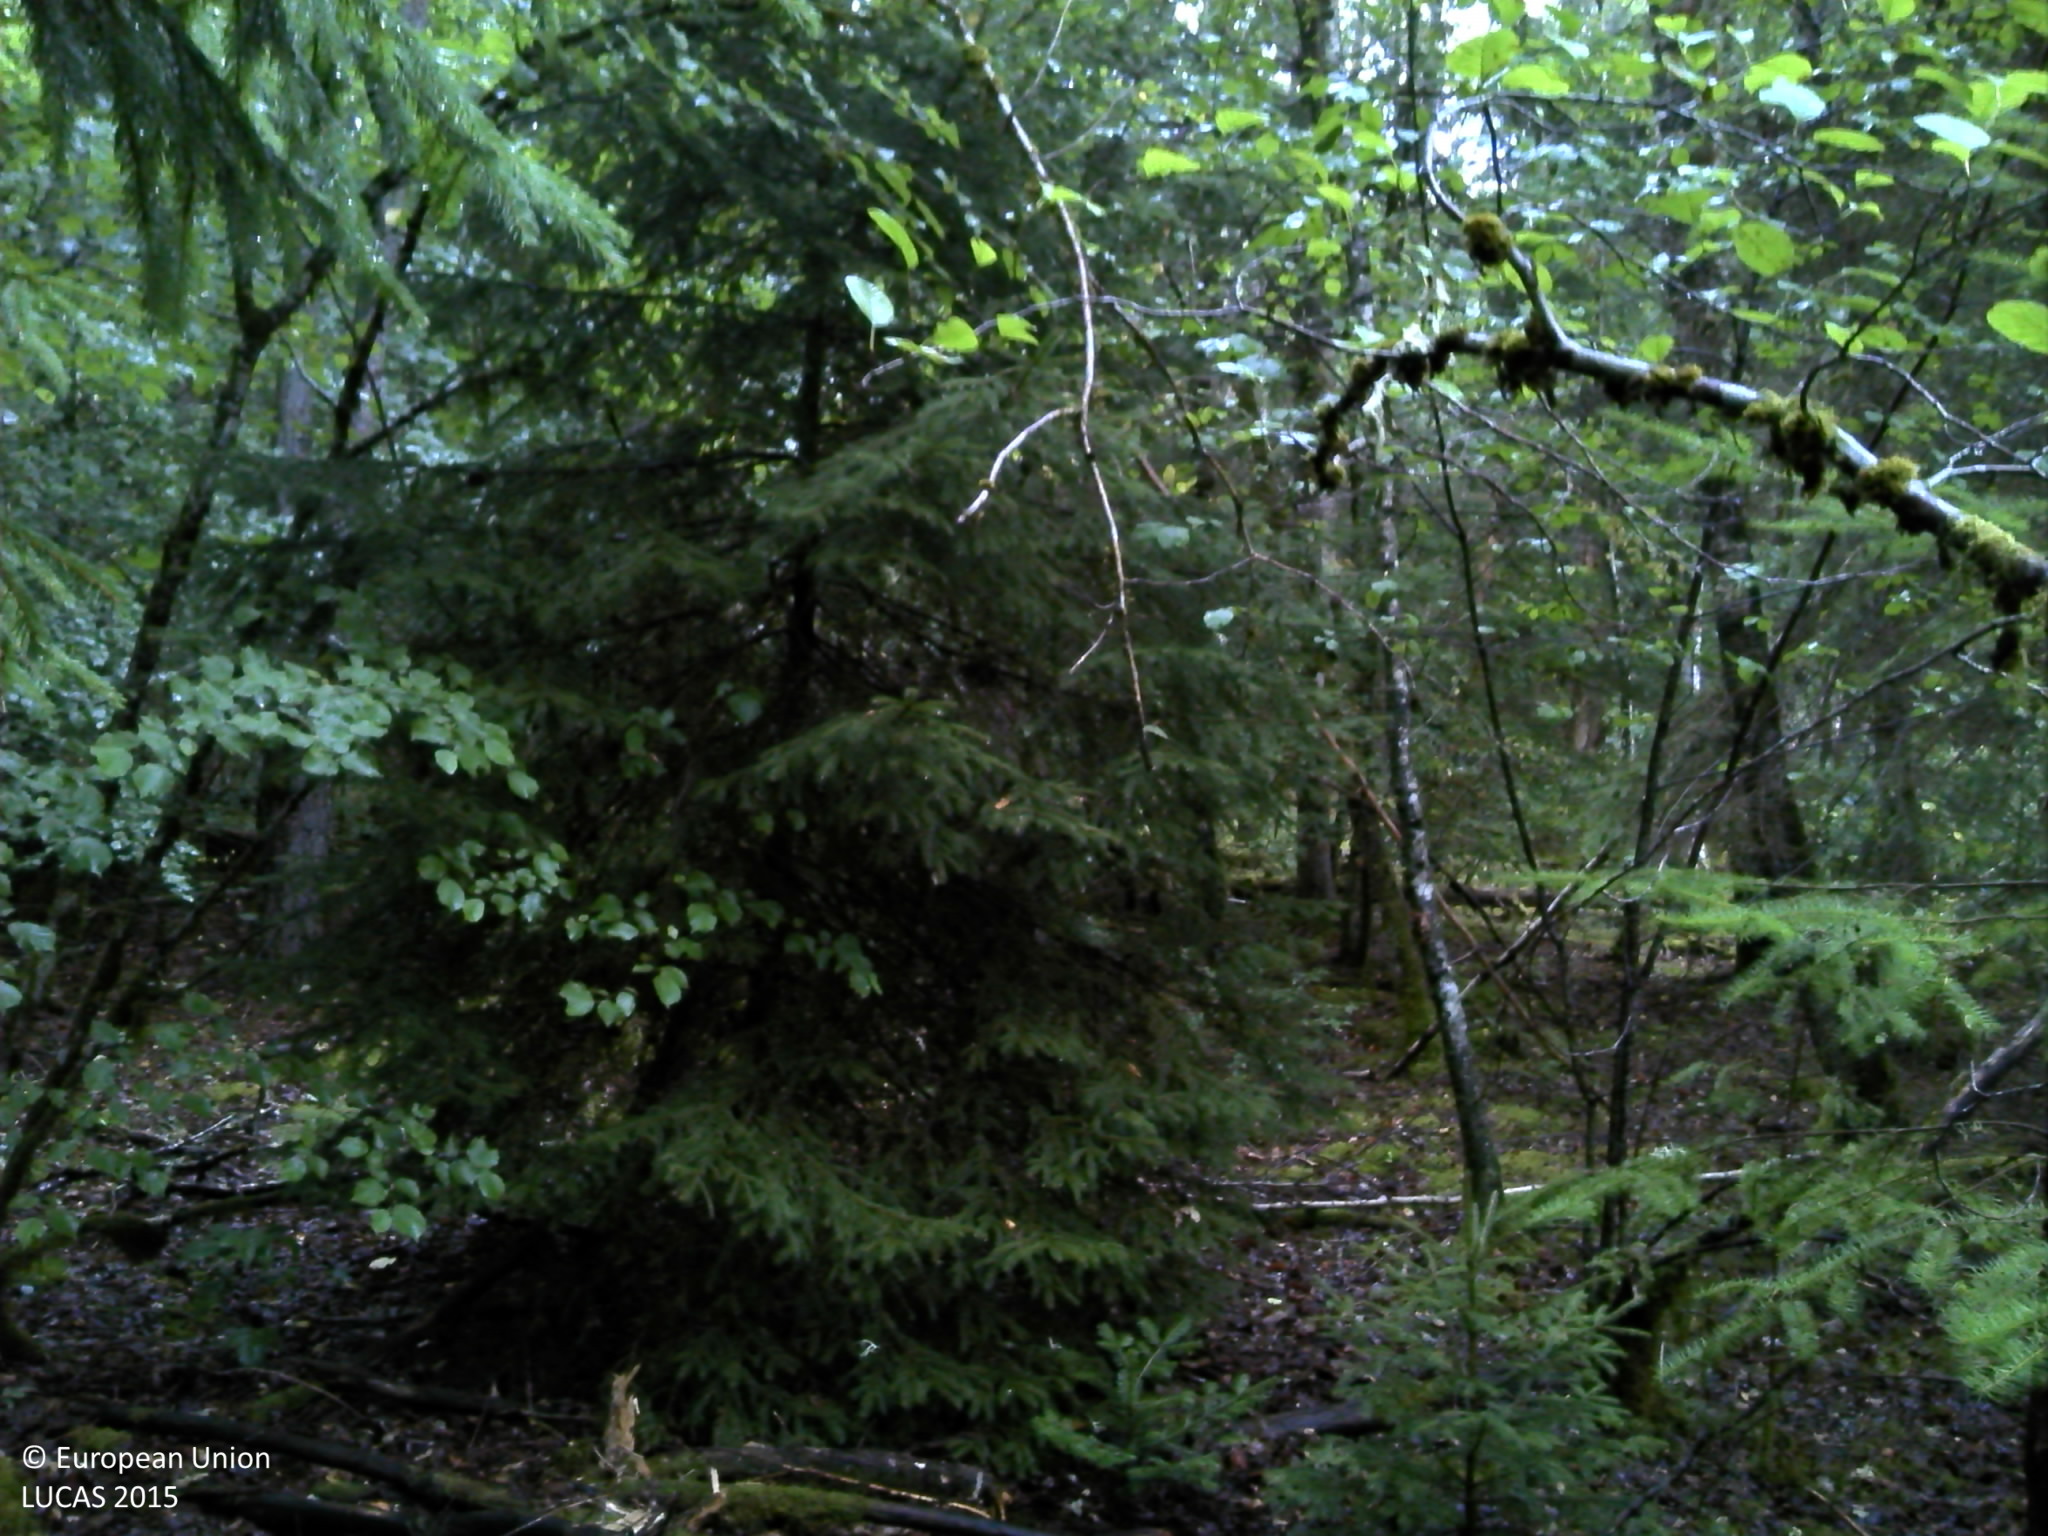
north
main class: Woodland
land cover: Spruce dominated mixed woodland
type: mountainous beech forest
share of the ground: > 75 %
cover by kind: broadleaved forest trees 35 %, coniferous forest trees 30 %, lichens and mosses 20 %, unconsolidated bare surface 15 %
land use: Semi-natural and natural areas not in use
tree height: > 5 m
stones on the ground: < 10 %
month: August
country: FR
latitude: 45.4270
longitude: 2.3679
